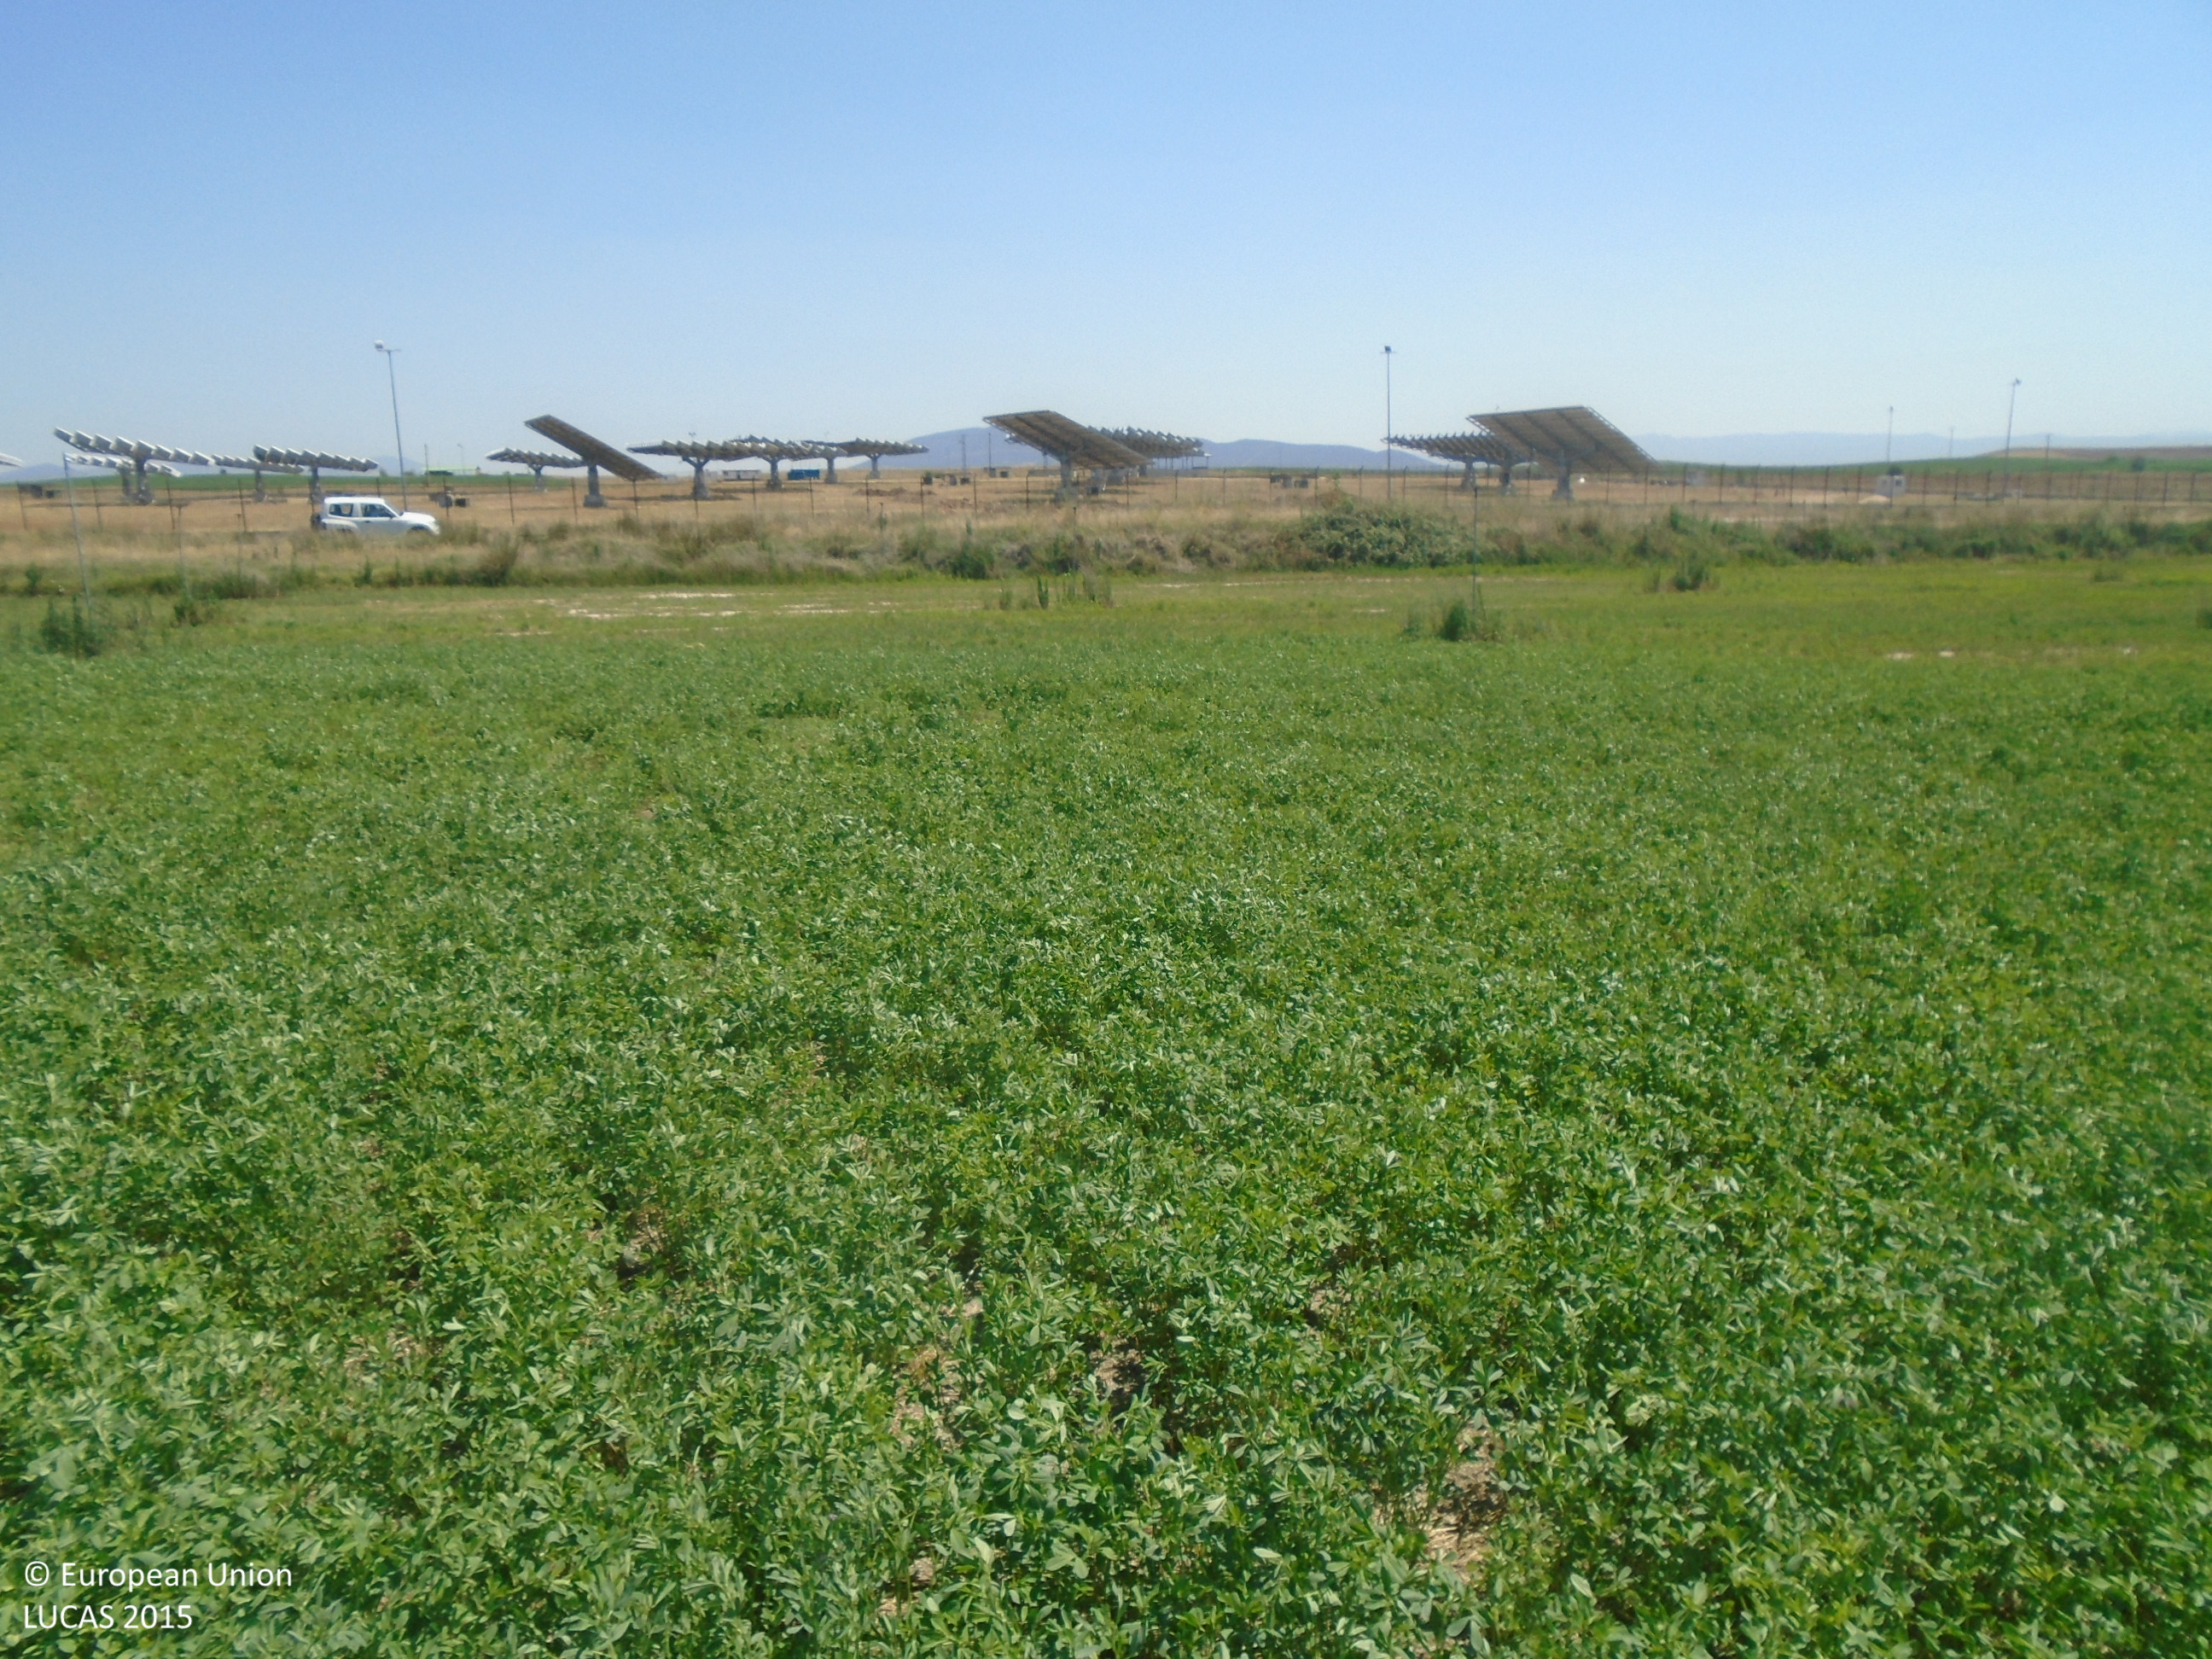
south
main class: Cropland
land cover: Lucerne
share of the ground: > 75 %
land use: Agriculture (excluding fallow land and kitchen gardens)
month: July
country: ES
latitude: 39.8243
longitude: -5.1102
